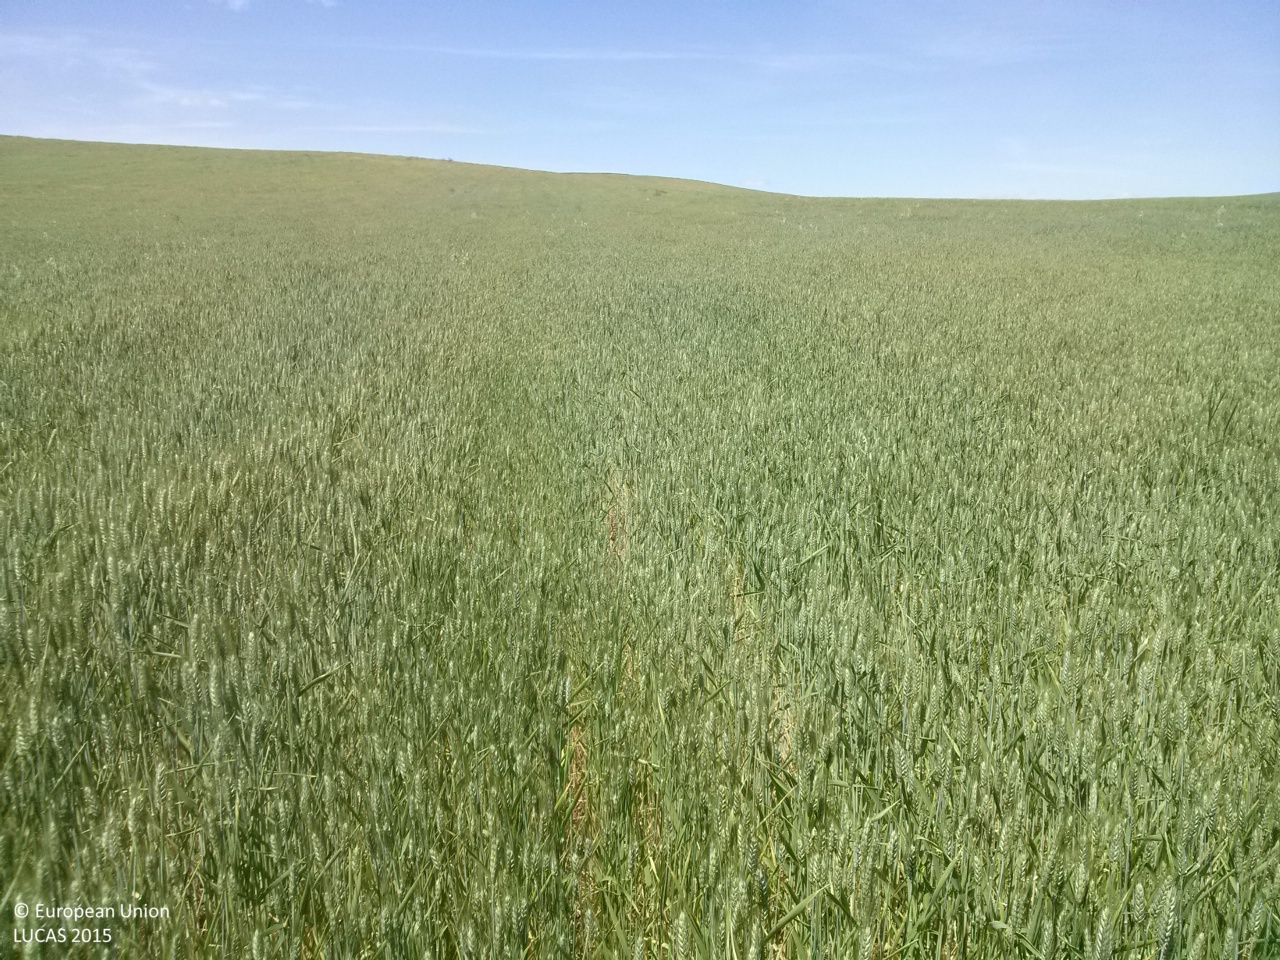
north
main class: Cropland
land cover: Common wheat
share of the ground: > 75 %
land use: Agriculture (excluding fallow land and kitchen gardens)
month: May
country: ES
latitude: 40.1410
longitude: -2.7816
